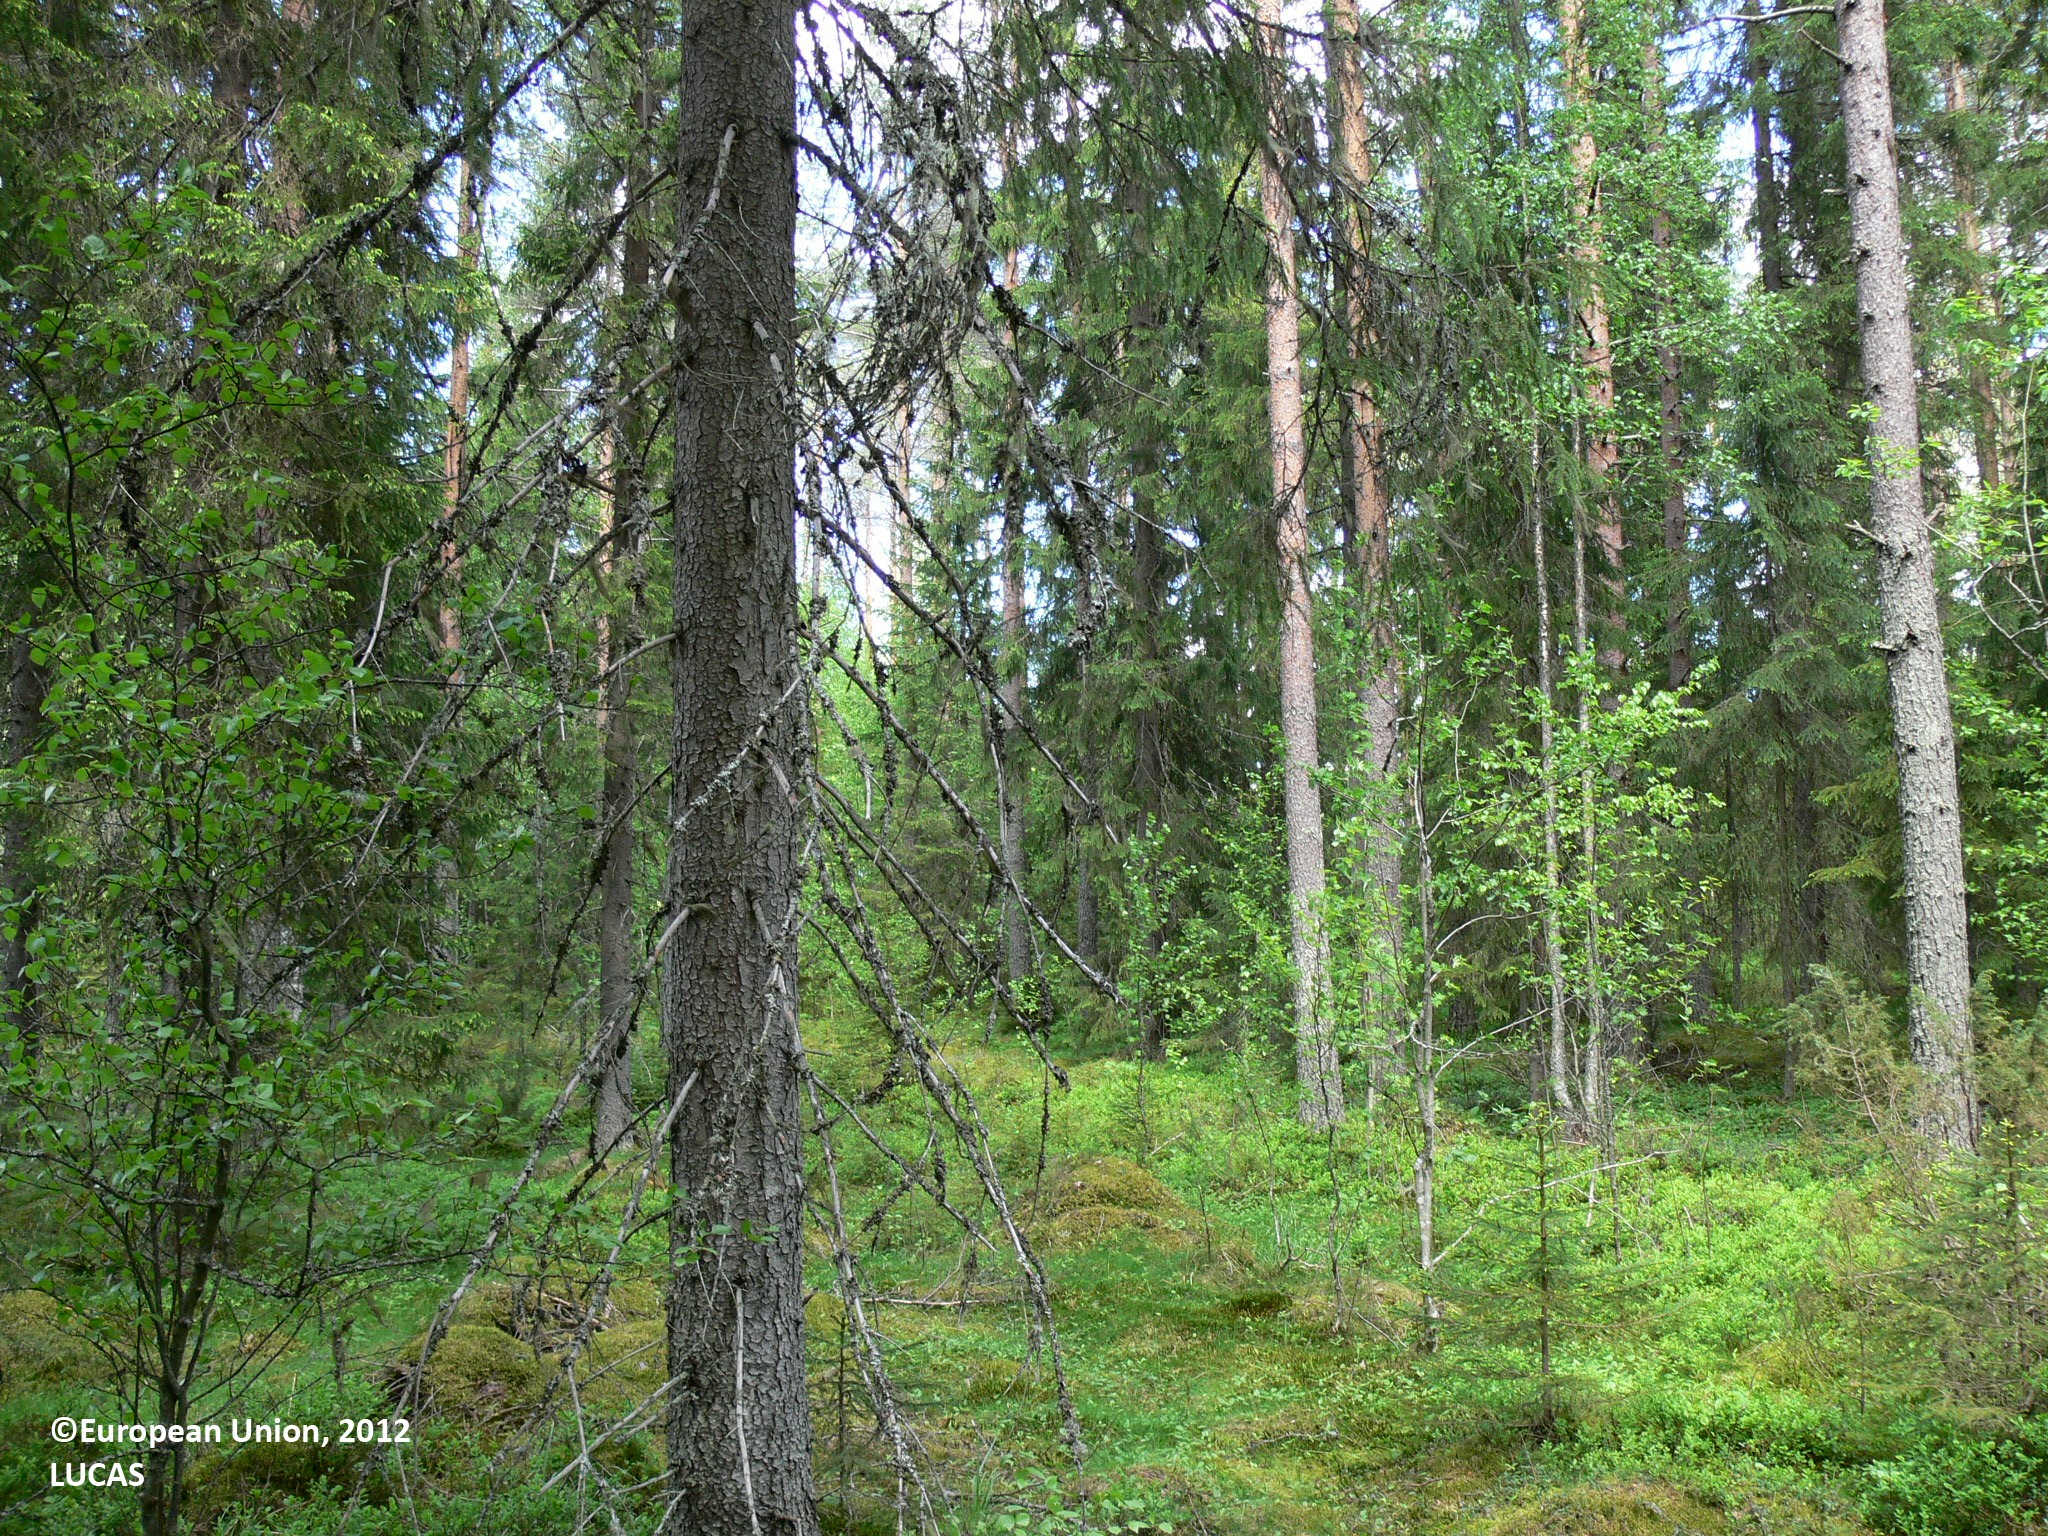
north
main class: Woodland
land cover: Spruce dominated coniferous woodland
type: boreal forest
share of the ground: > 75 %
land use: Forestry
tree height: > 5 m
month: June
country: FI
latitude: 62.5658
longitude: 30.6180
